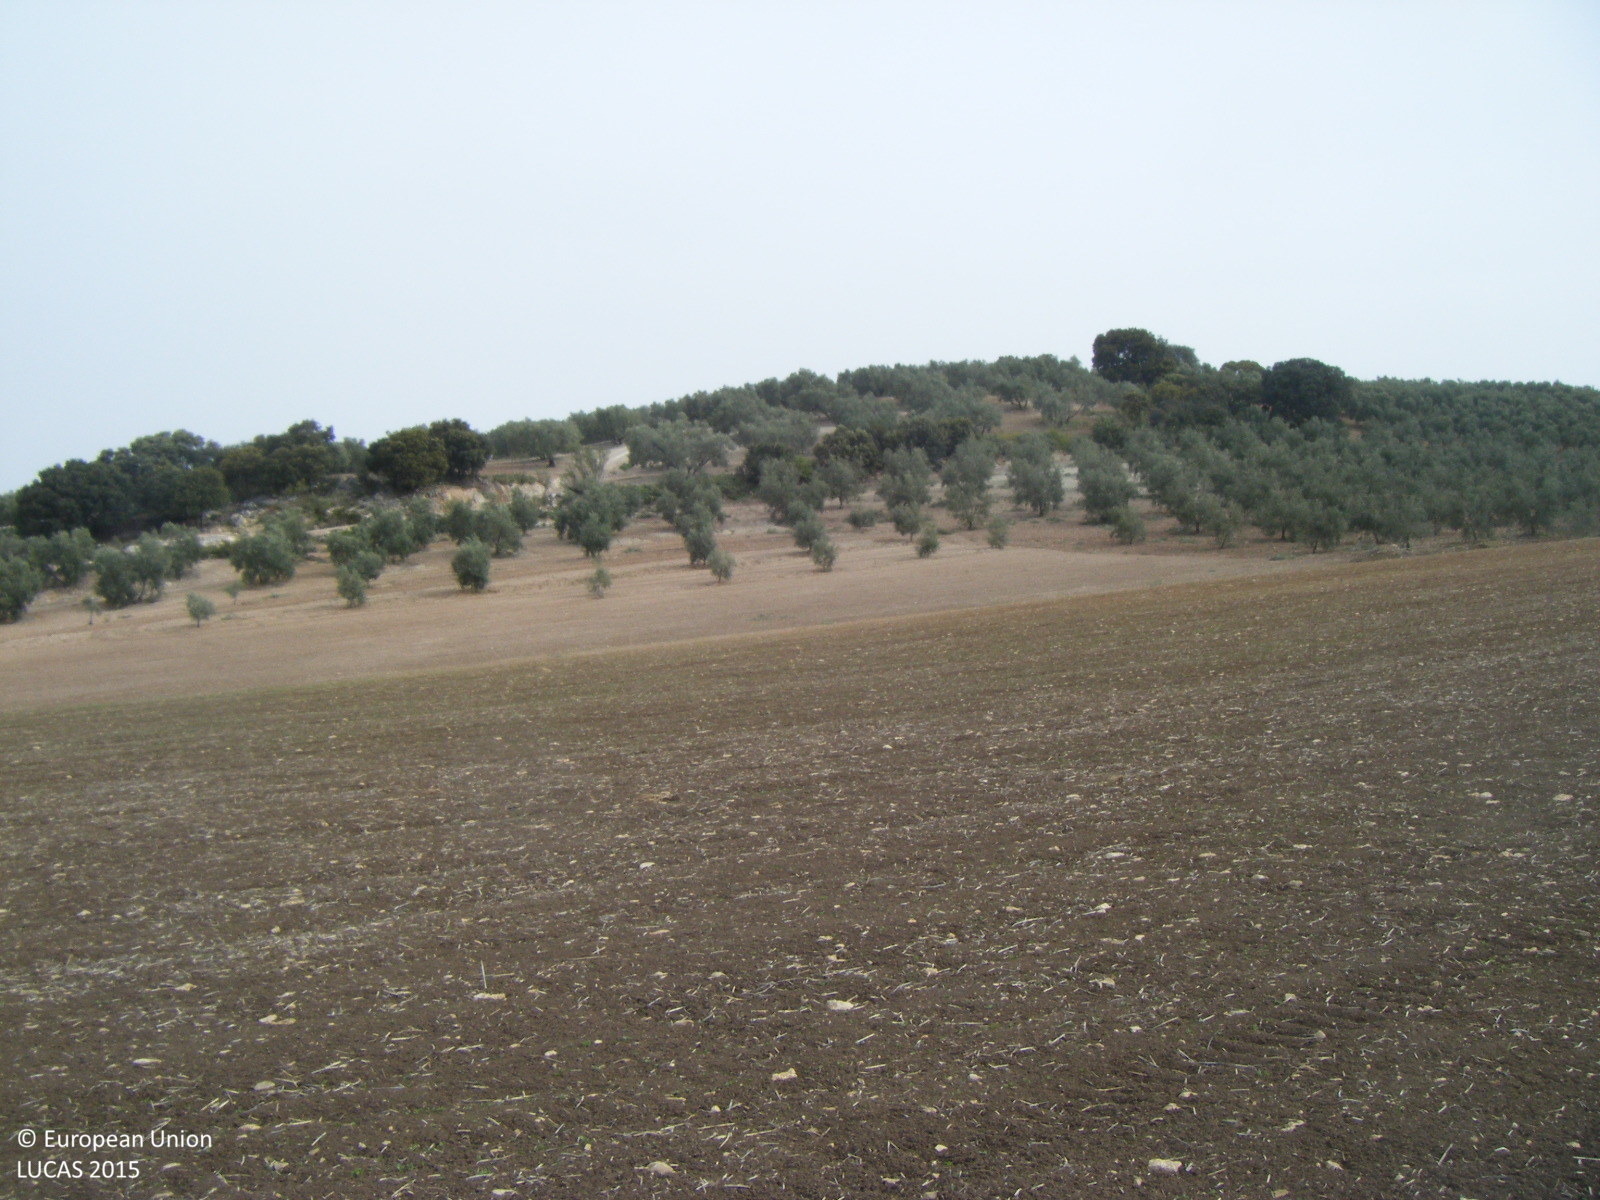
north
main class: Cropland
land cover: Other non-permanent industrial crops
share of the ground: < 10 %
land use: Agriculture (excluding fallow land and kitchen gardens)
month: April
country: ES
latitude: 37.0847
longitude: -4.2929
